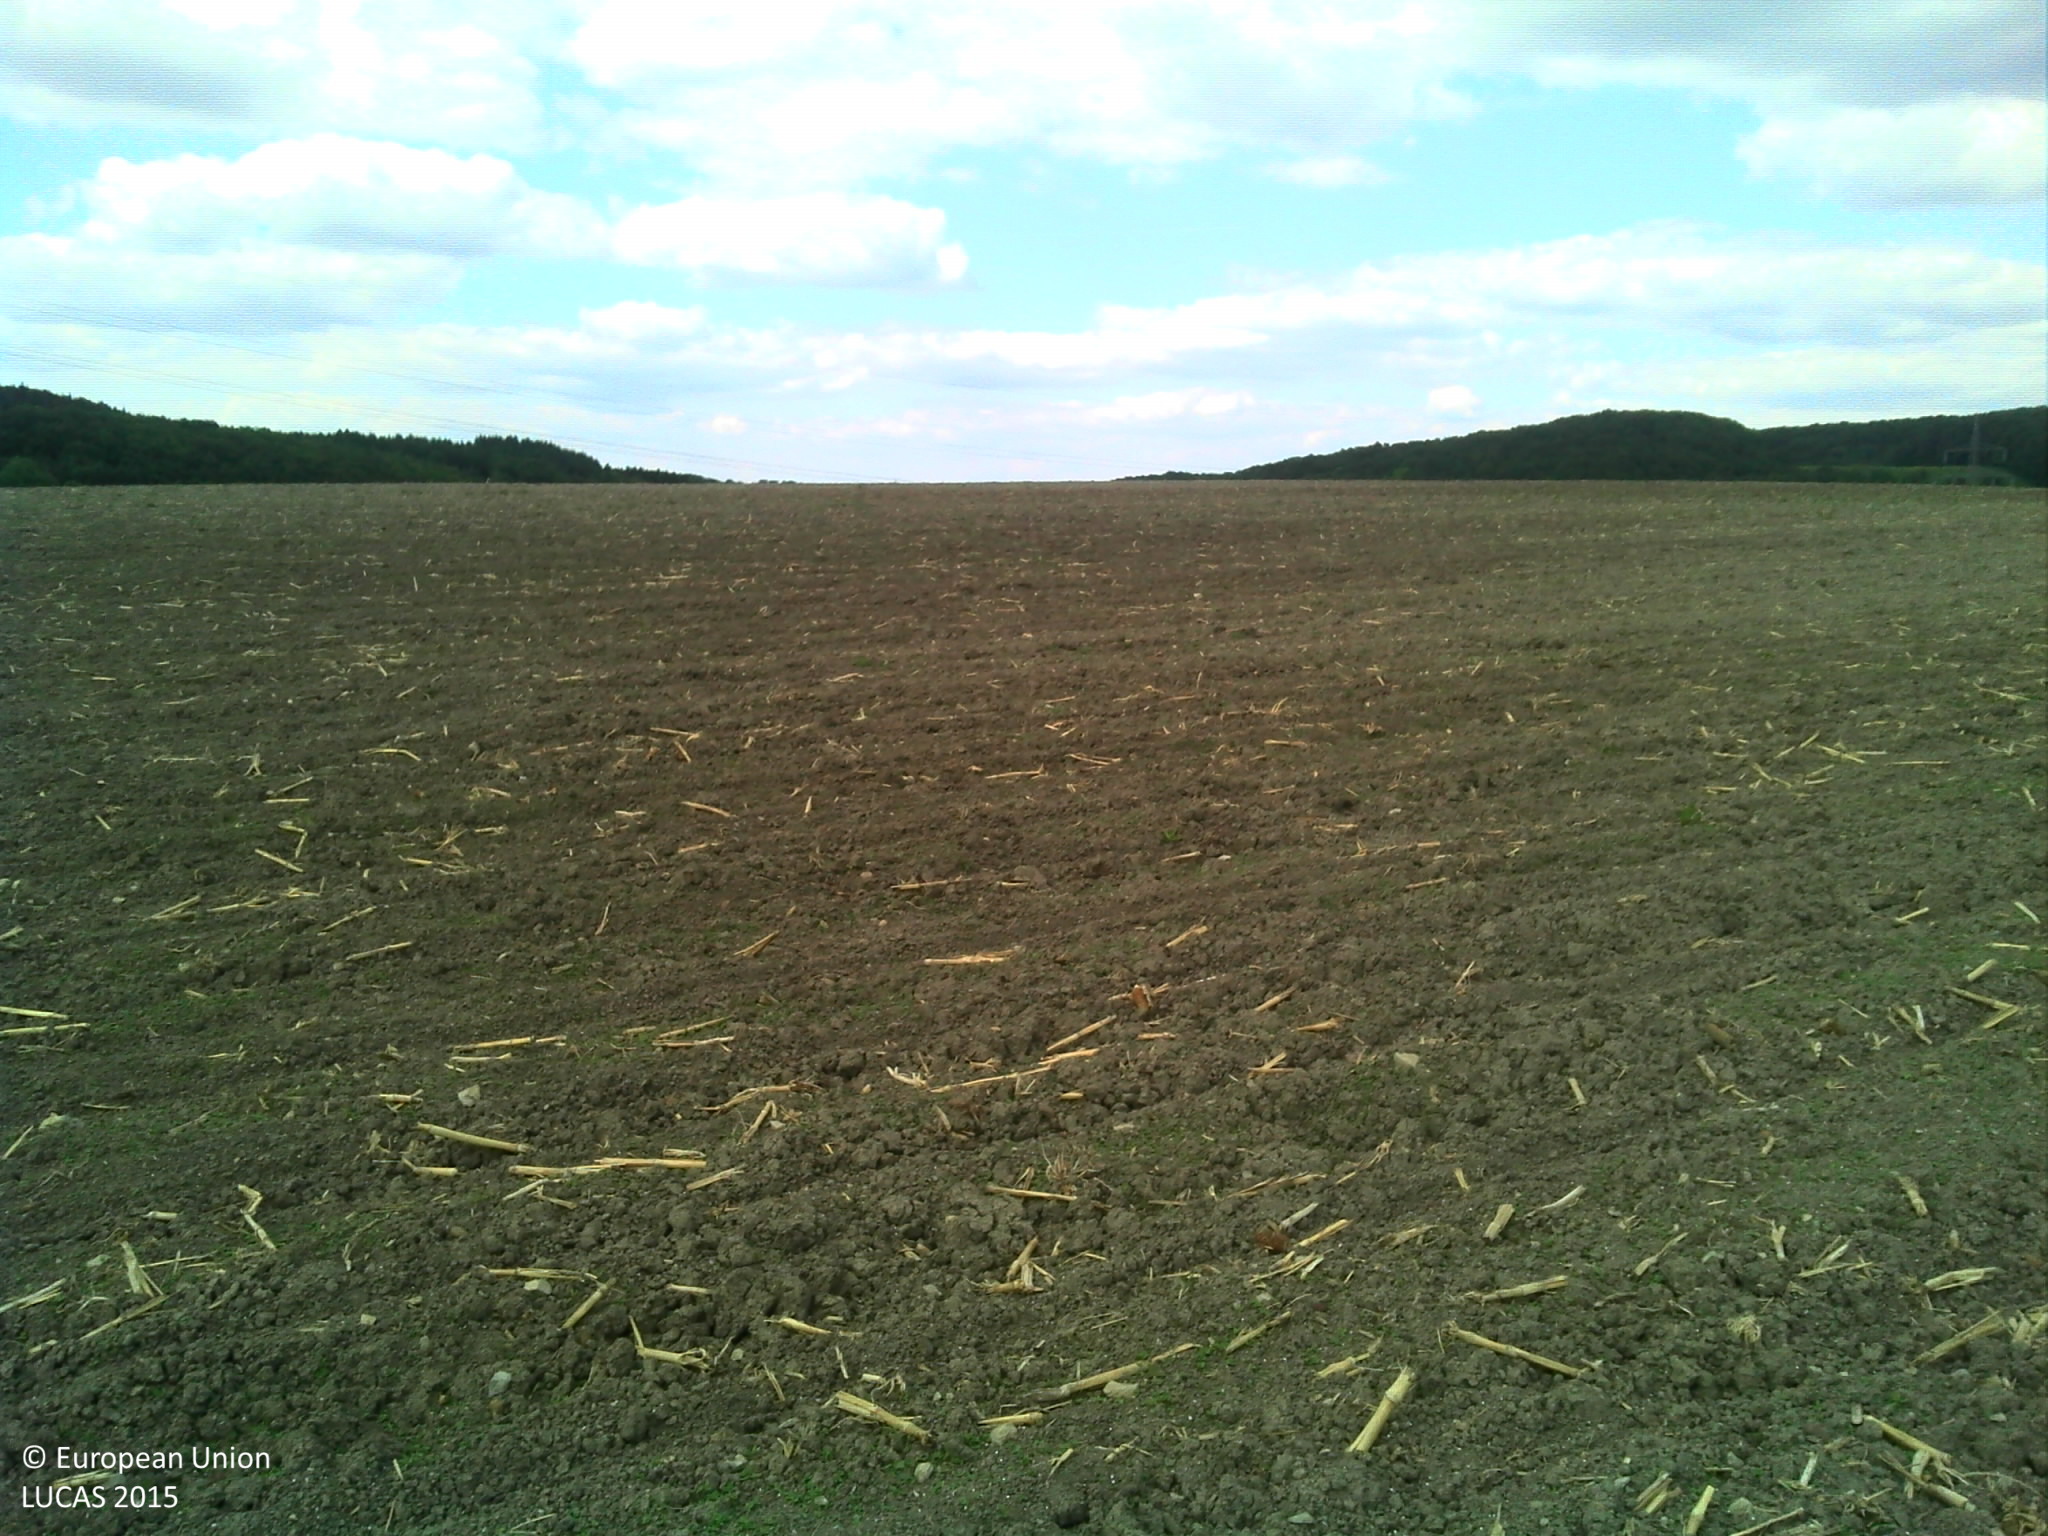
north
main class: Cropland
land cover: Maize
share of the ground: < 10 %
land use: Agriculture (excluding fallow land and kitchen gardens)
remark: Tilled/Sowed
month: May
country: LU
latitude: 49.7271
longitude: 6.2678
